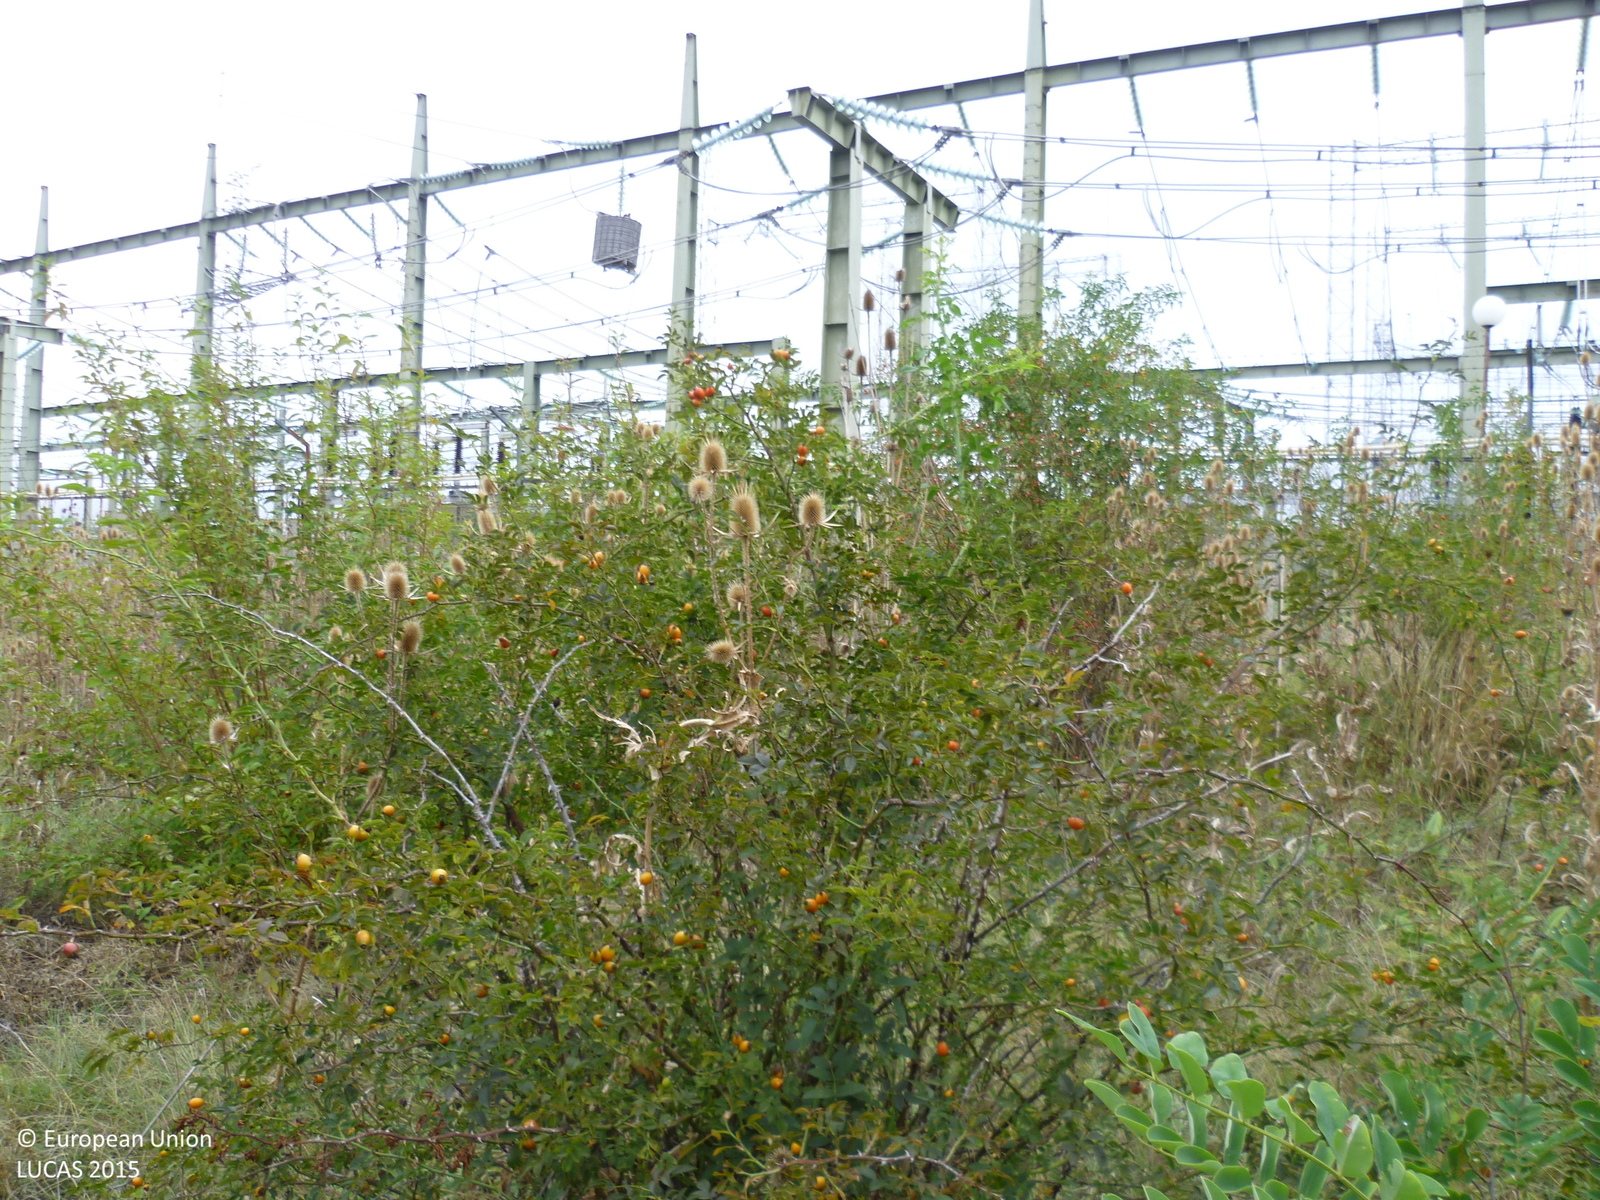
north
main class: Grassland
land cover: Grassland with sparse tree/shrub cover
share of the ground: > 75 %
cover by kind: herbaceous plants 85 %, shrubs 10 %, broadleaved forest trees 5 %
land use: Fallow land
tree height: > 5 m
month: September
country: BG
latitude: 42.8472
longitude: 23.1880
